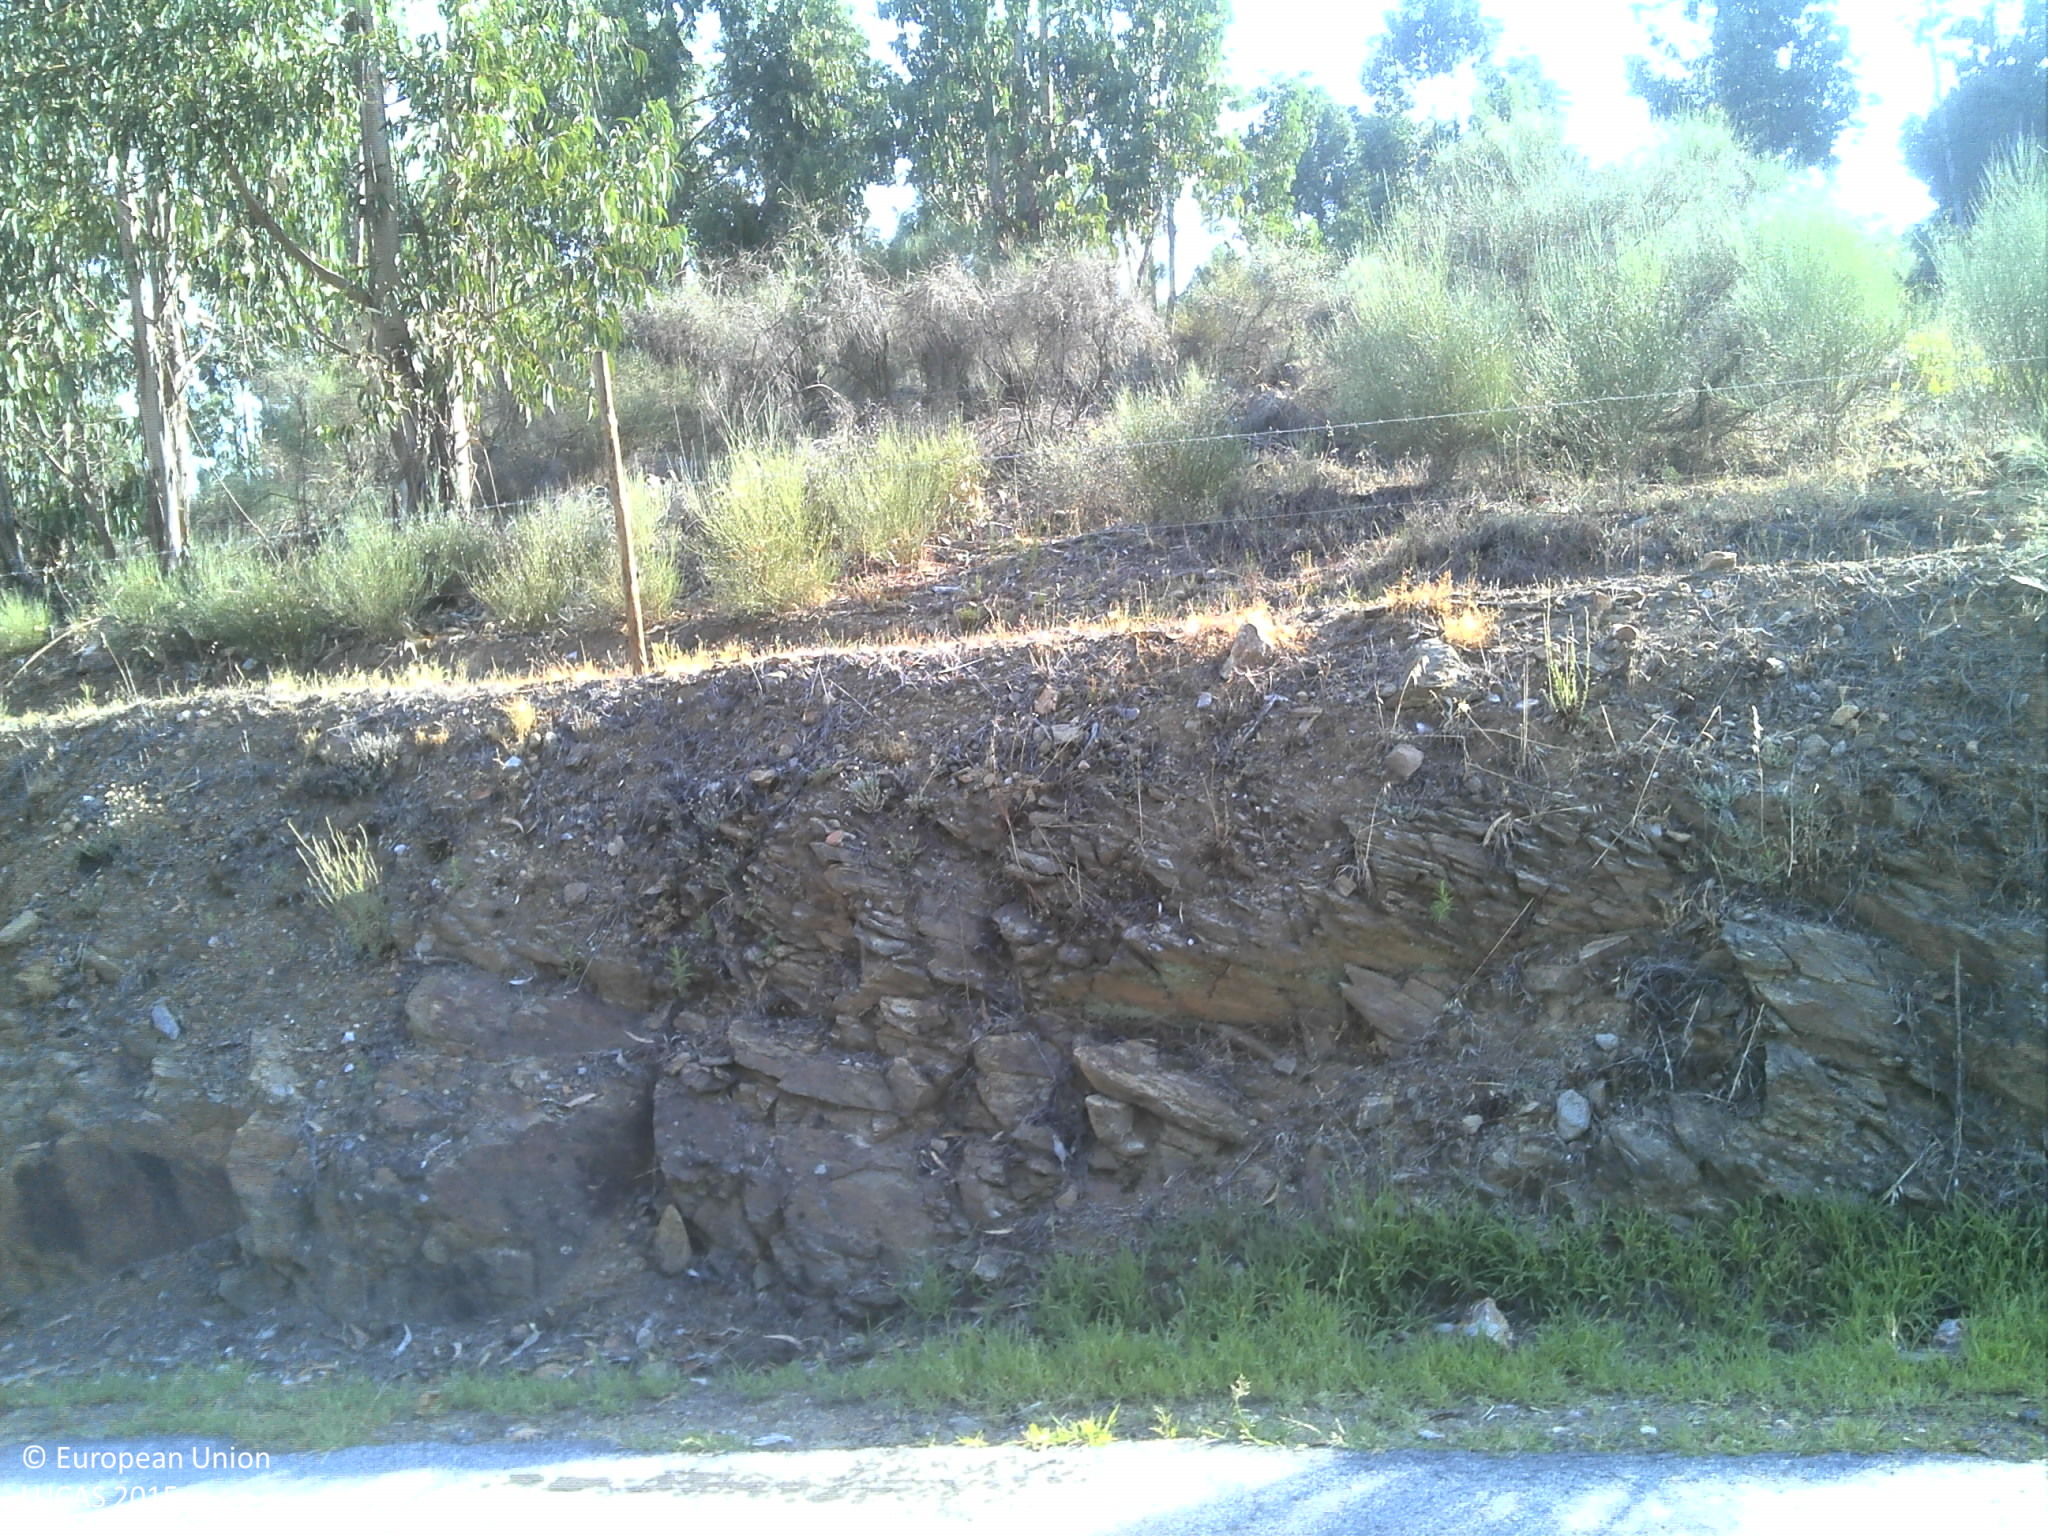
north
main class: Woodland
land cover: Broadleaved woodland
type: broadleaved evergreen forest
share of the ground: 50 - 75 %
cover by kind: broadleaved forest trees 50 %, herbaceous plants 40 %, unconsolidated bare surface 10 %
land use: Forestry
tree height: > 5 m
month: June
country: PT
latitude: 39.9185
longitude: -7.1862
